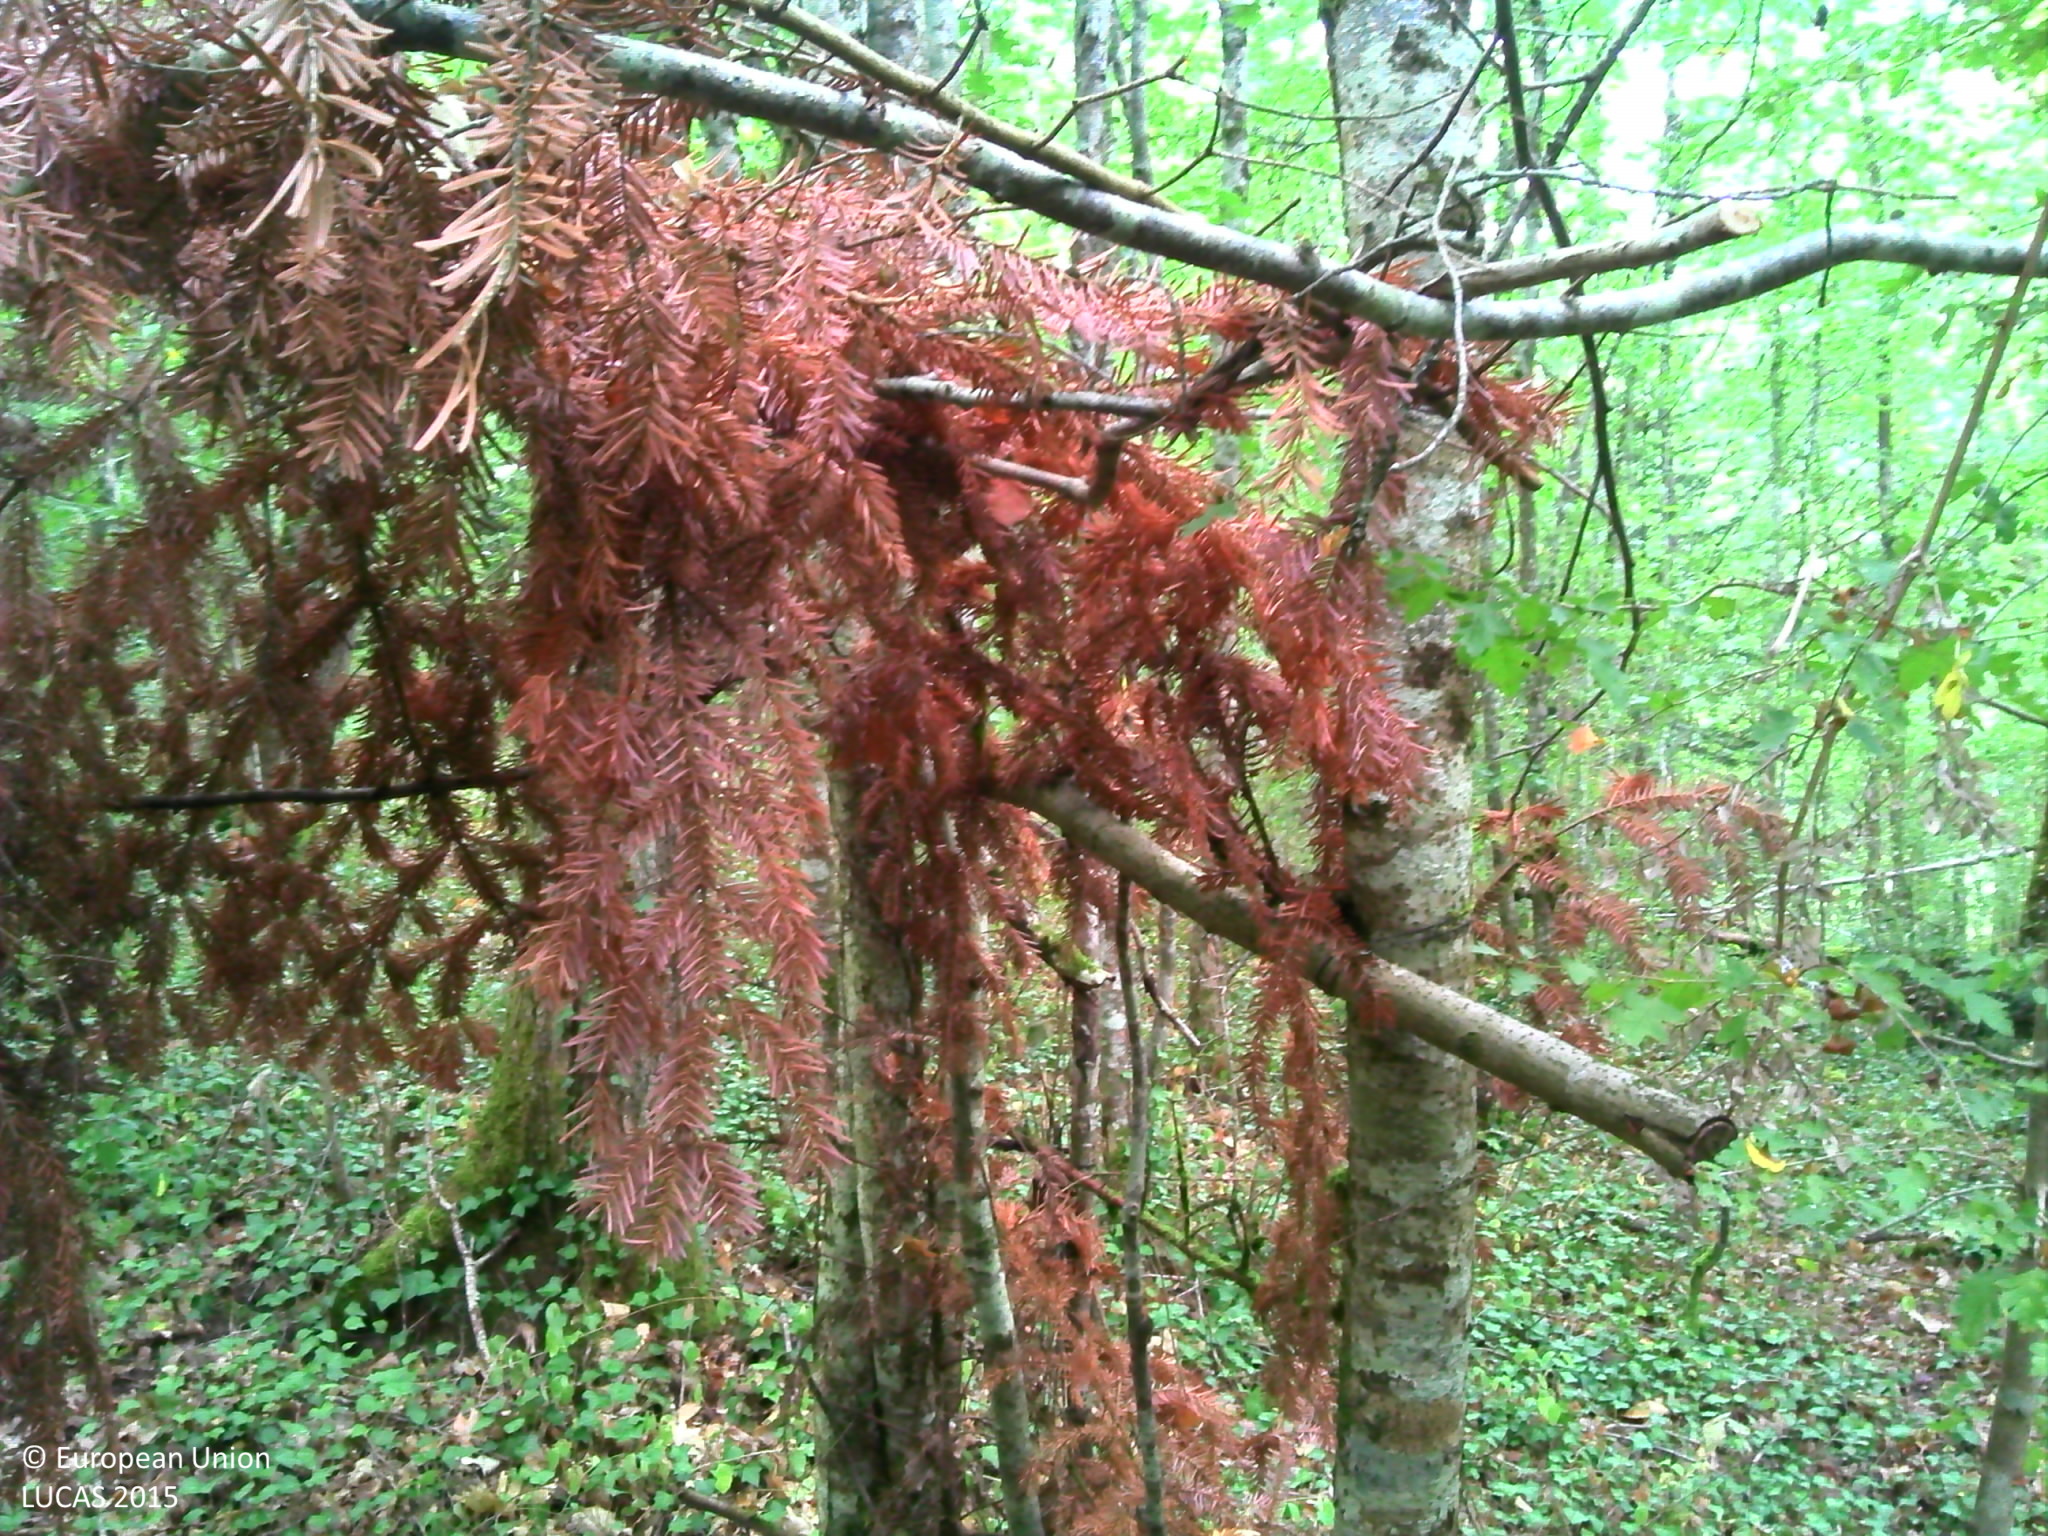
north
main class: Woodland
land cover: Broadleaved woodland
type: thermophilous deciduous forest
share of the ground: > 75 %
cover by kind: broadleaved forest trees 85 %, herbaceous plants 15 %
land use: Forestry
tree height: > 5 m
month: August
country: FR
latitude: 44.2376
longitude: 0.6667
